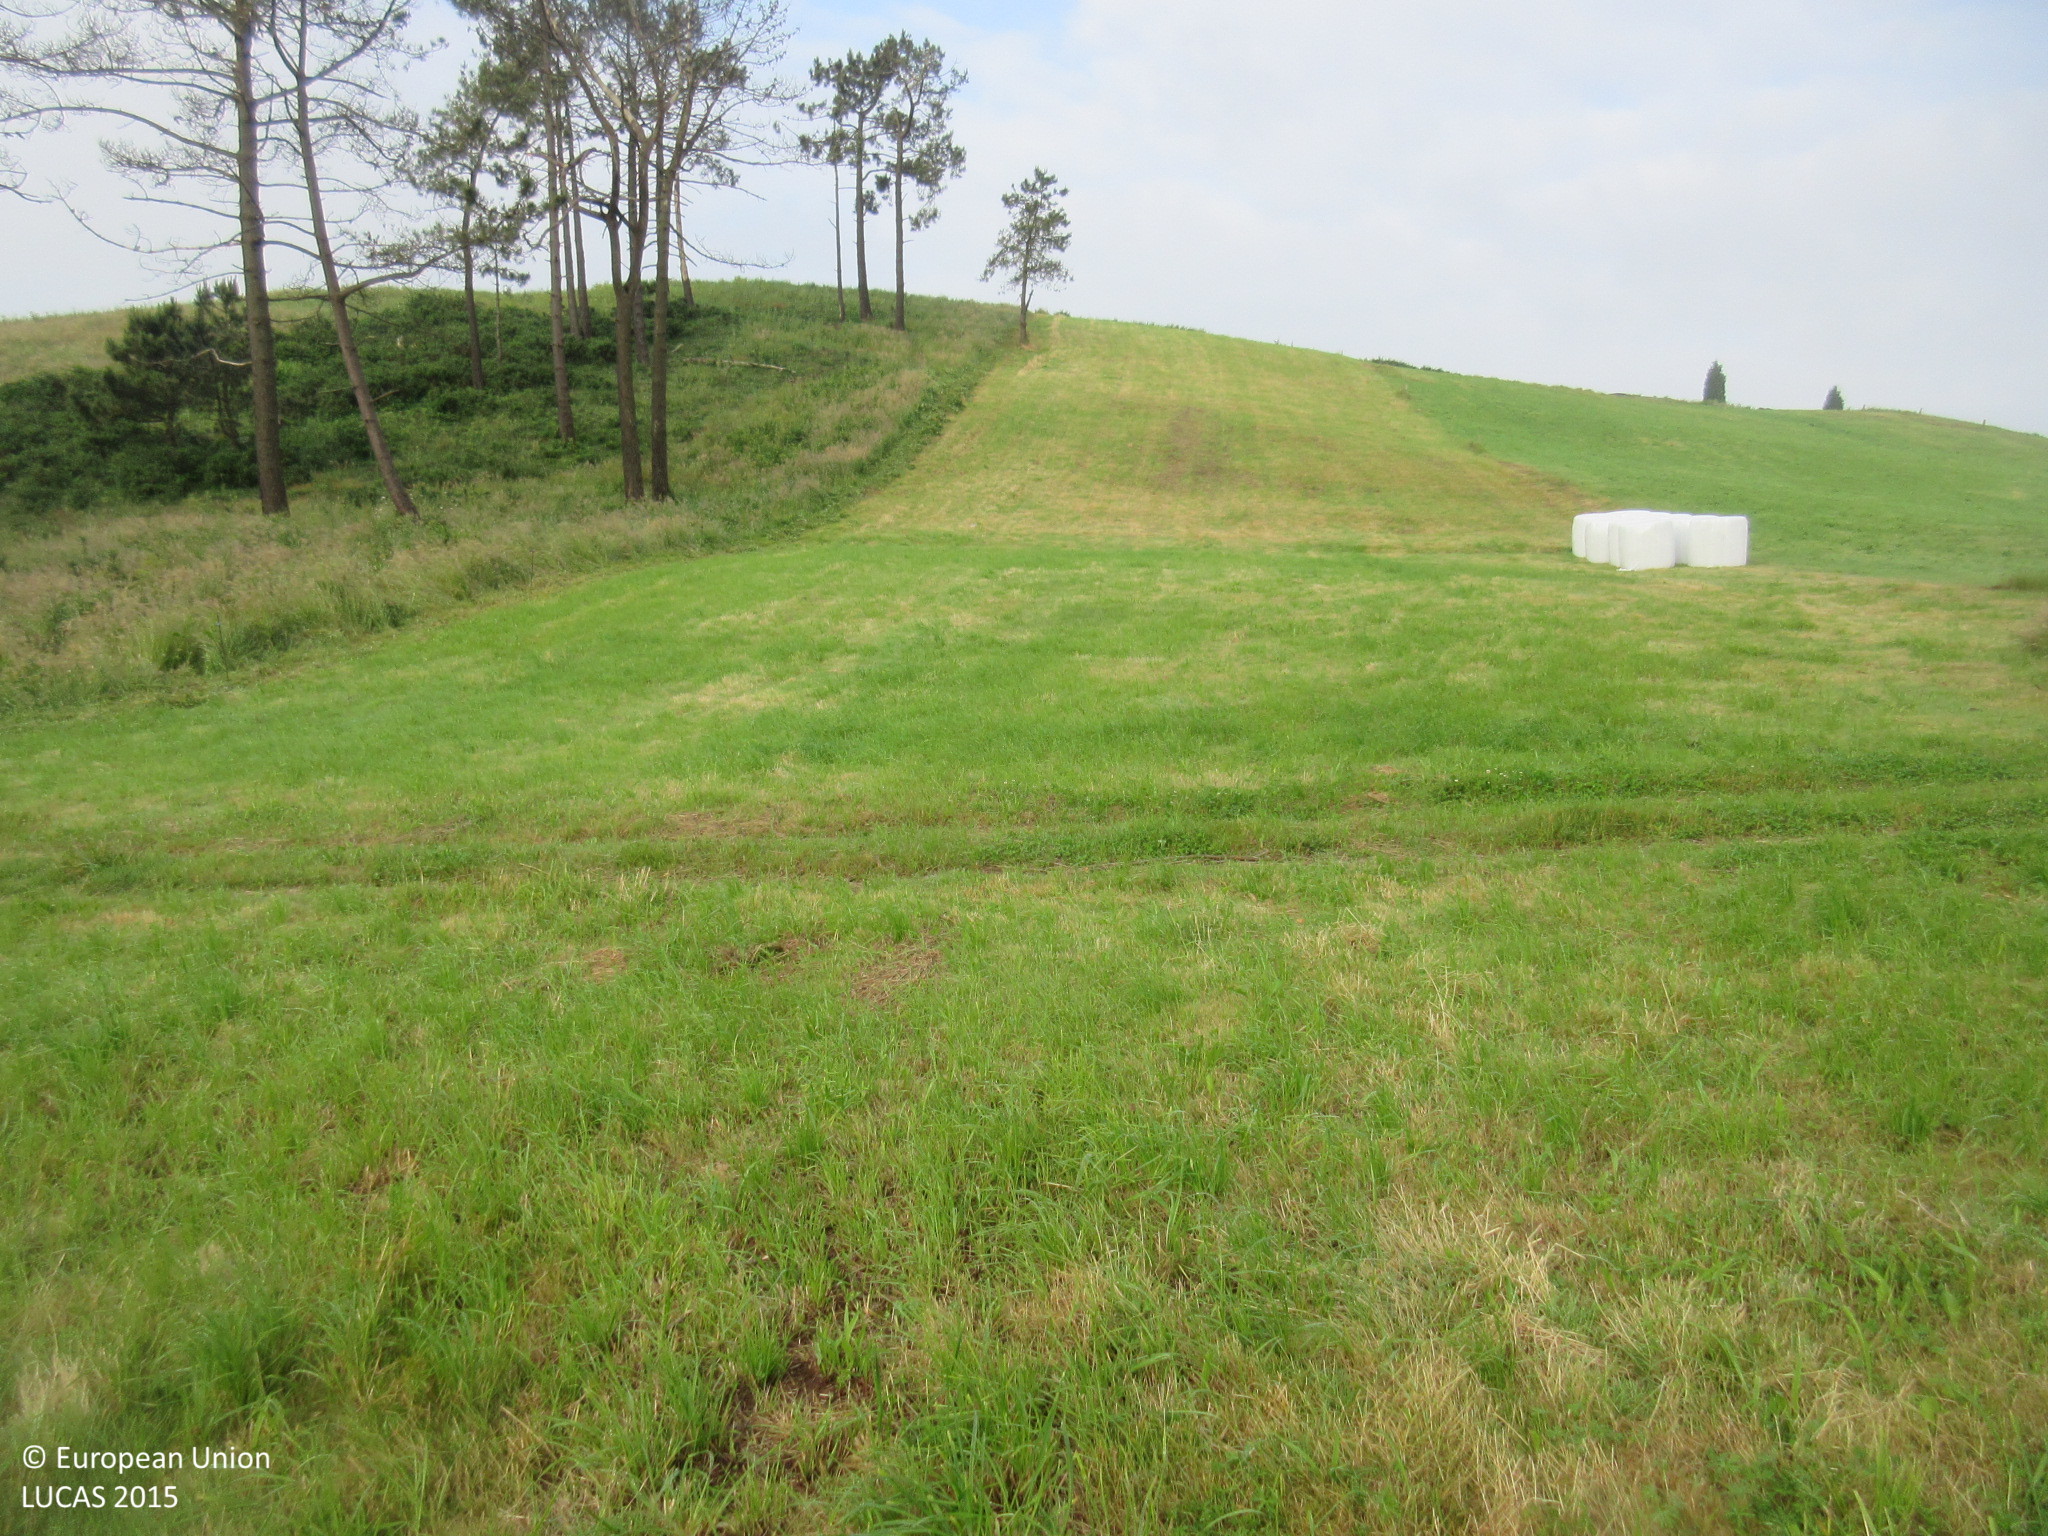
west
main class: Grassland
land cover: Grassland without tree/shrub cover
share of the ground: > 75 %
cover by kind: herbaceous plants 100 %
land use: Agriculture (excluding fallow land and kitchen gardens)
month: June
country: ES
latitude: 43.4642
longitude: -5.8986
